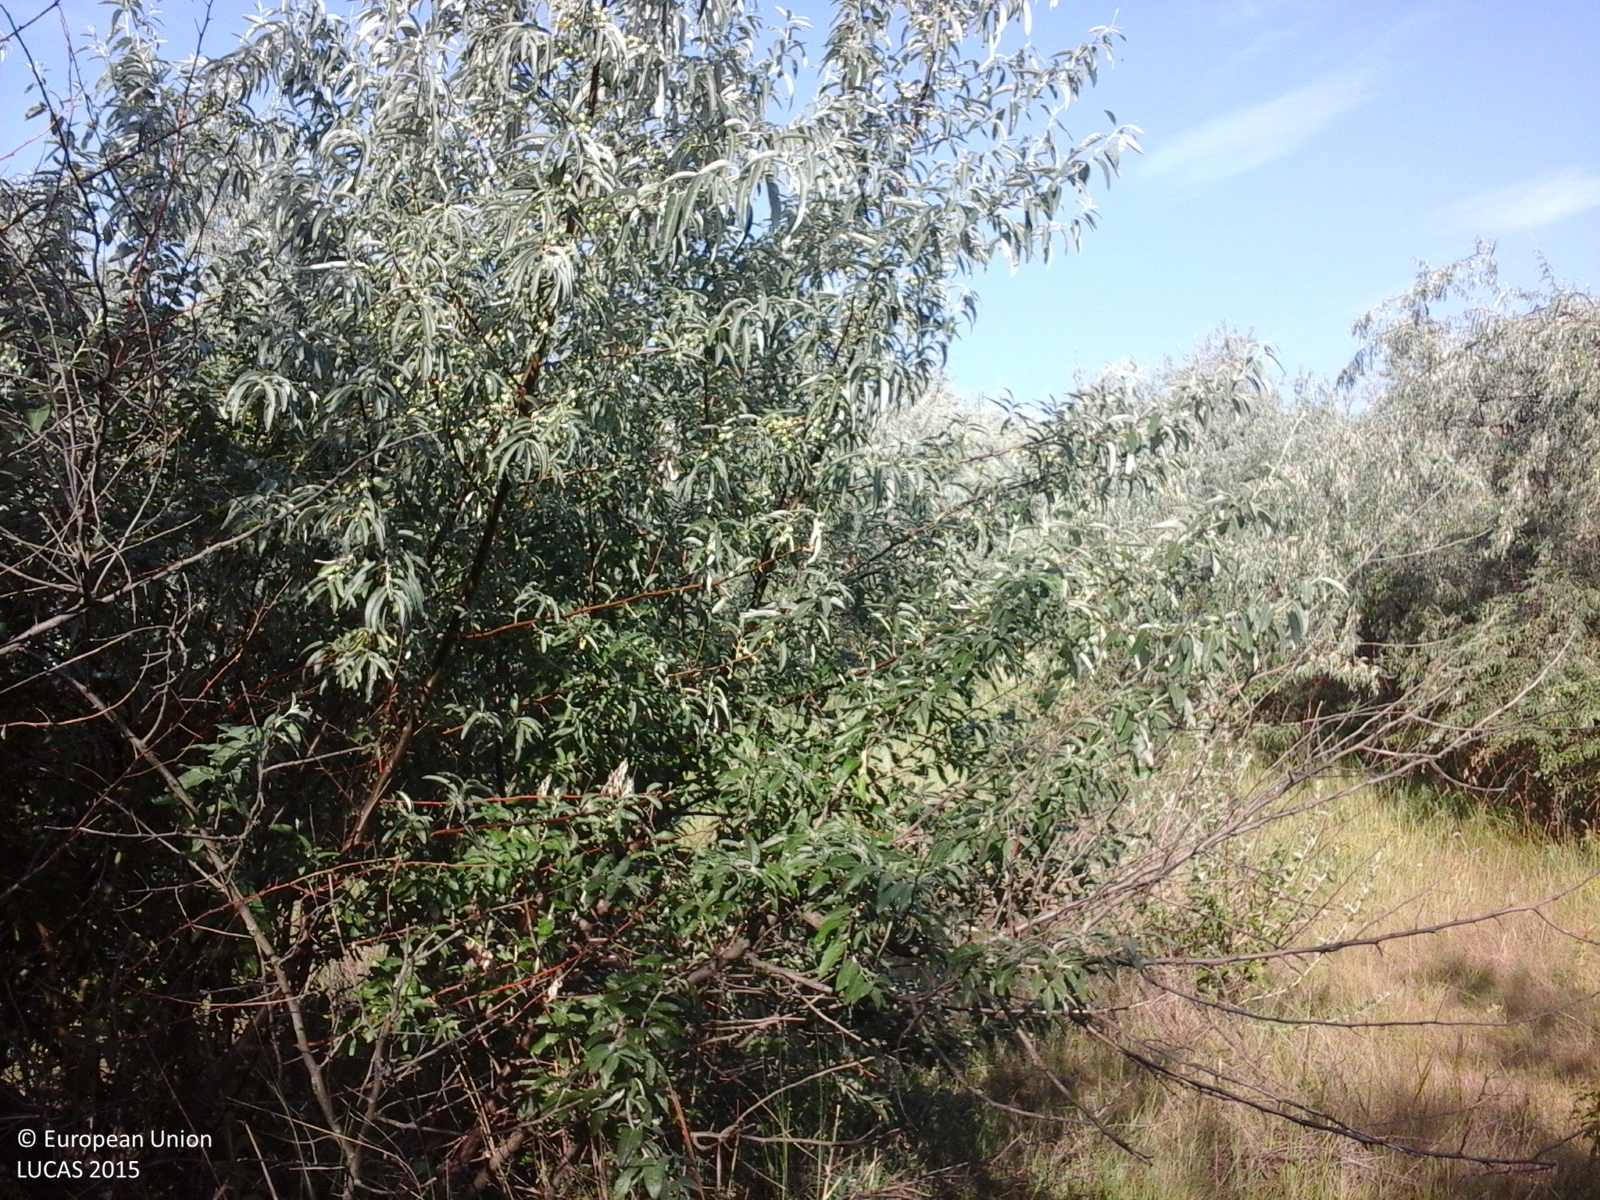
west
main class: Shrubland
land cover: Shrubland without tree cover
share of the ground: > 75 %
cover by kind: shrubs 70 %, herbaceous plants 30 %
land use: Agriculture (excluding fallow land and kitchen gardens)
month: July
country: RO
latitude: 46.5313
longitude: 28.1632
